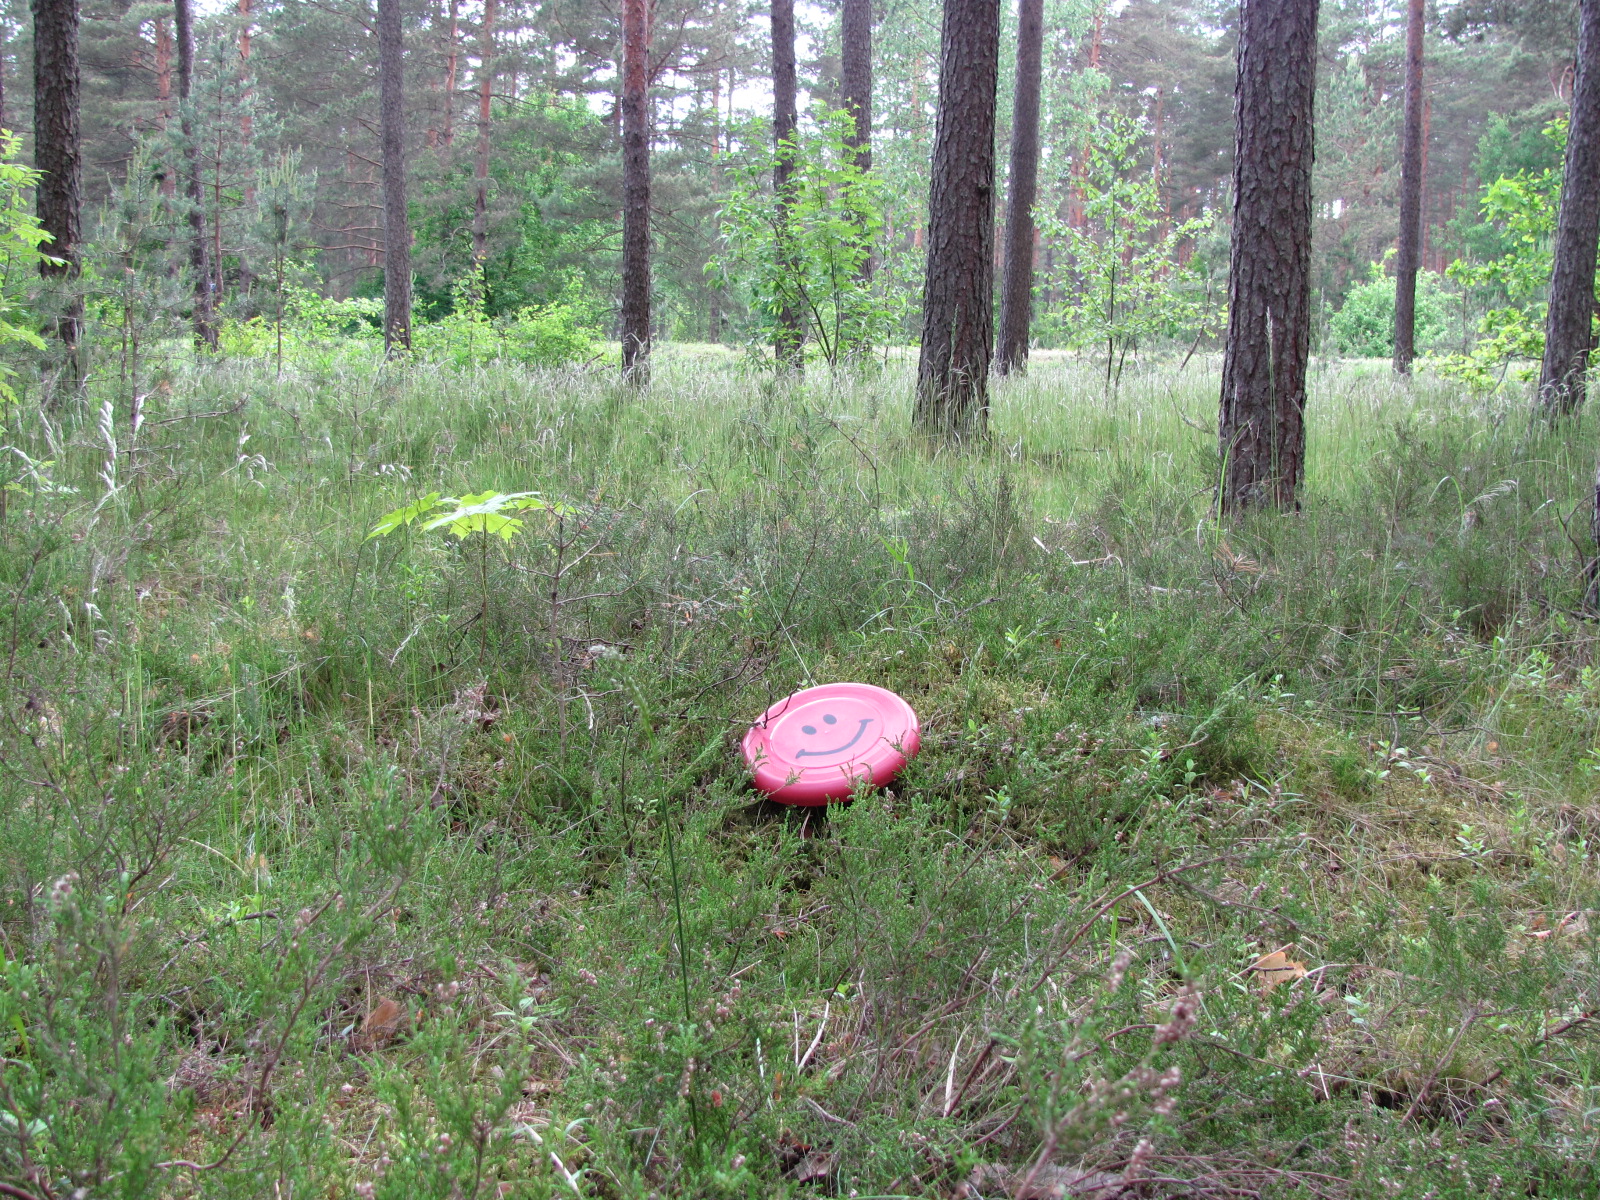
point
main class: Woodland
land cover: Pine dominated coniferous woodland
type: hemiboreal forest and nemoral coniferous forest and mixed broadleaved-coniferous forest
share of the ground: > 75 %
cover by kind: coniferous forest trees 85 %, lichens and mosses 10 %, herbaceous plants 5 %
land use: Forestry
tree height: > 5 m
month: June
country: LV
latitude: 56.9534
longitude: 24.3122
